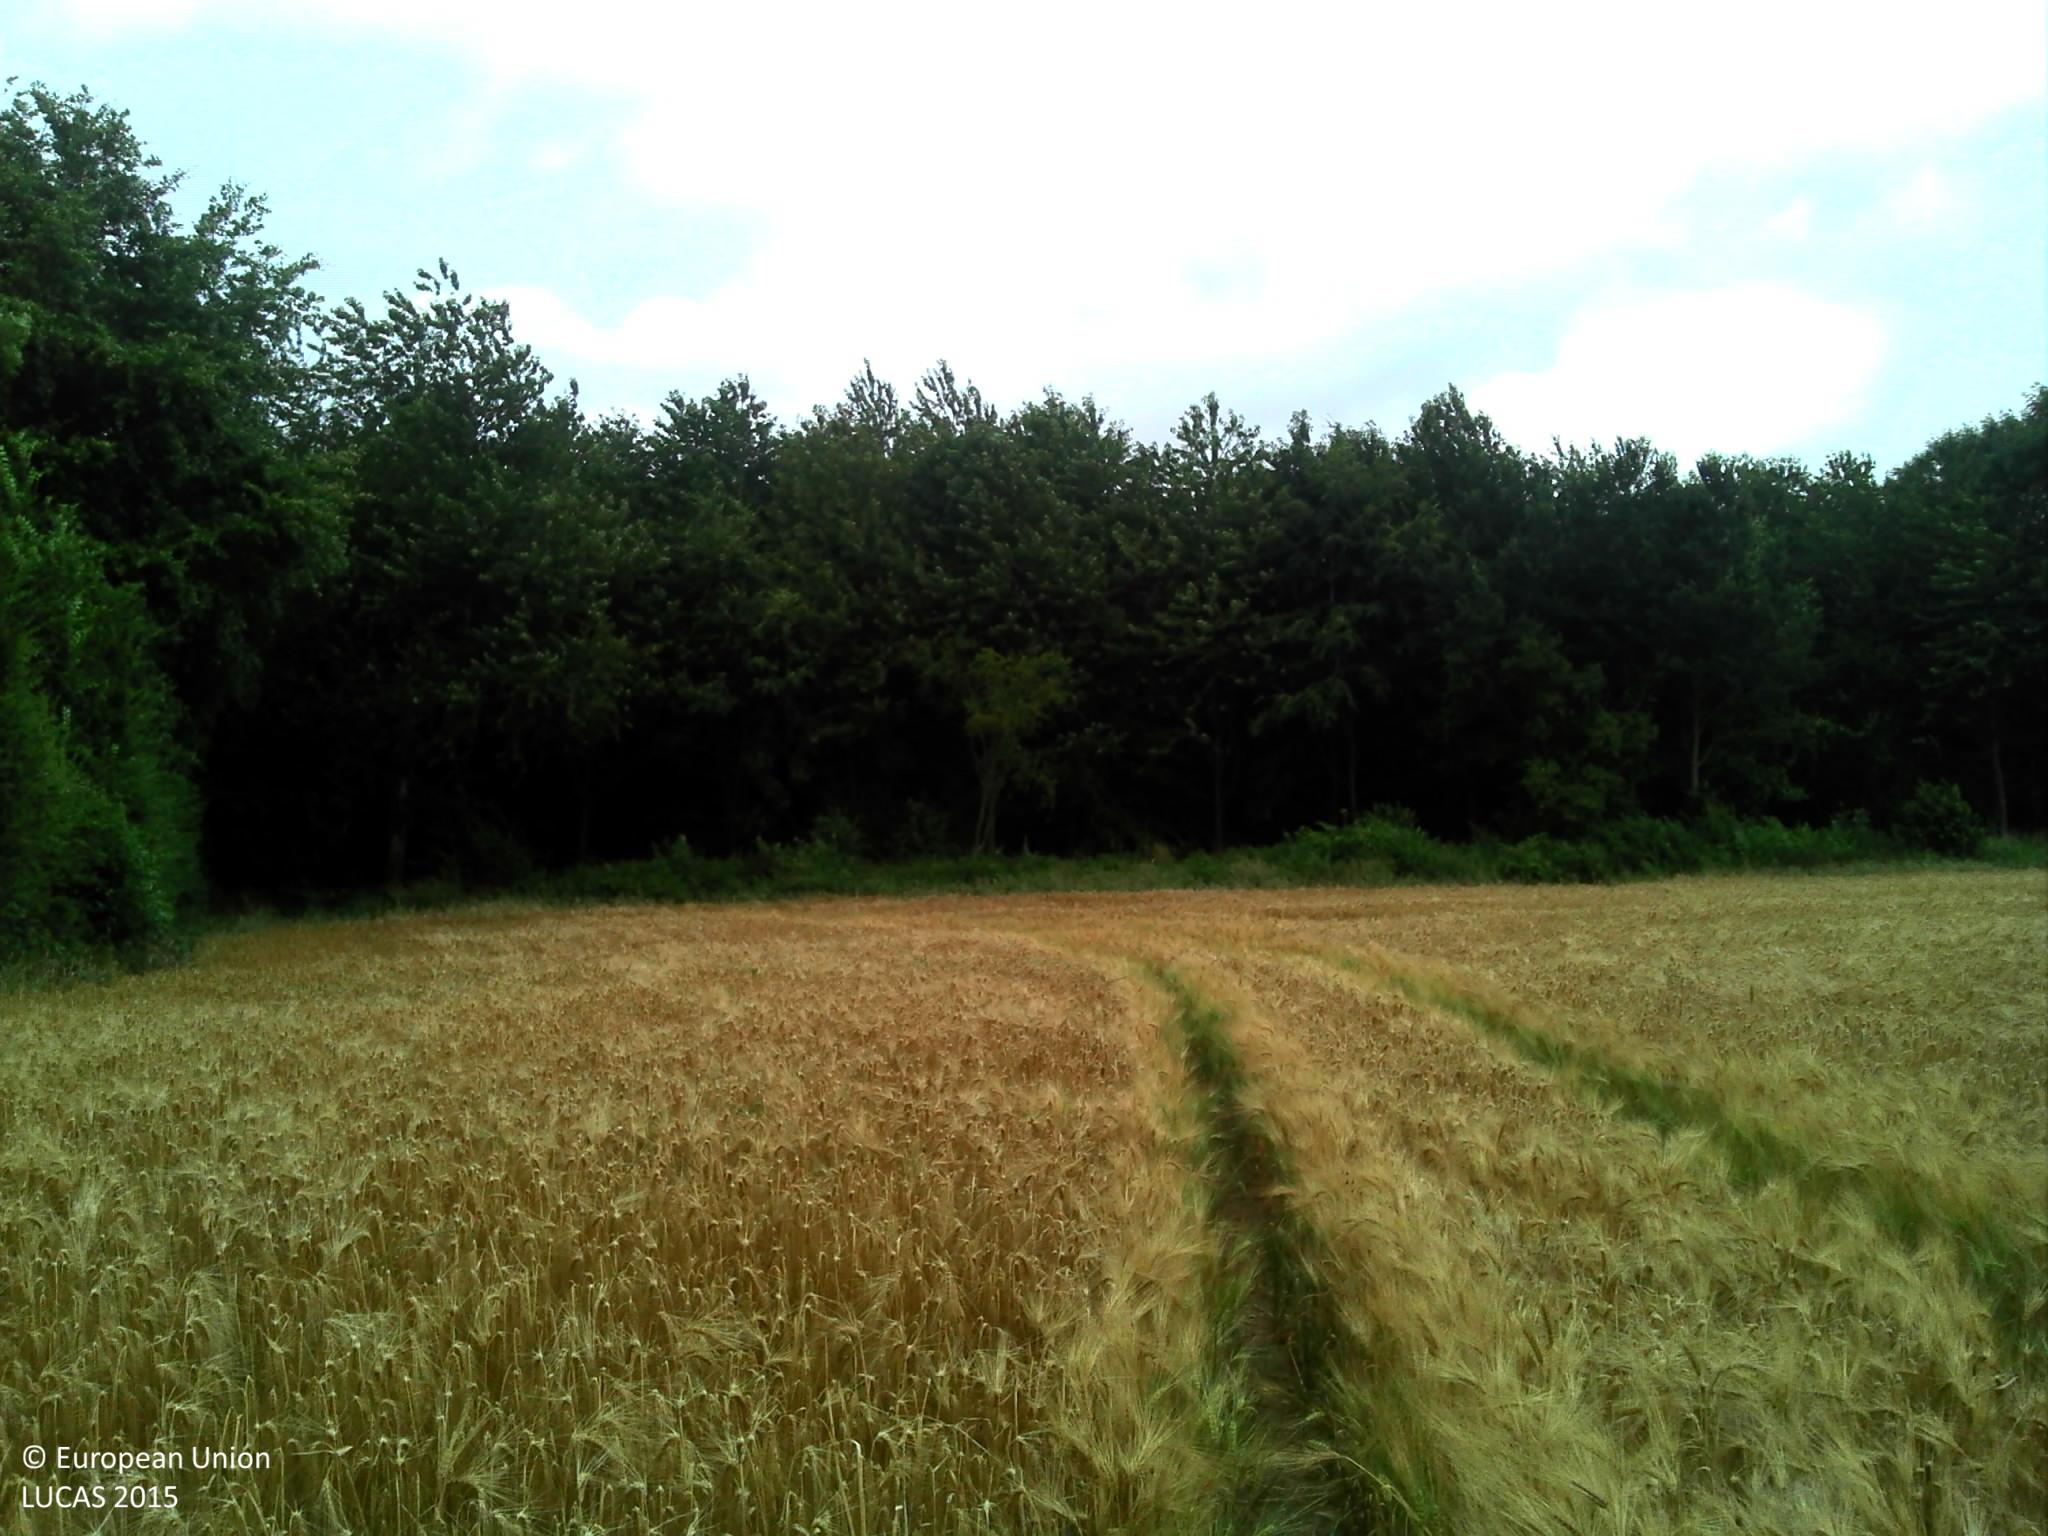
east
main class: Cropland
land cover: Barley
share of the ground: > 75 %
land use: Agriculture (excluding fallow land and kitchen gardens)
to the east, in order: Barley; Tracks; Broadleaved woodland
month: July
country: FR
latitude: 49.3287
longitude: 0.4374
